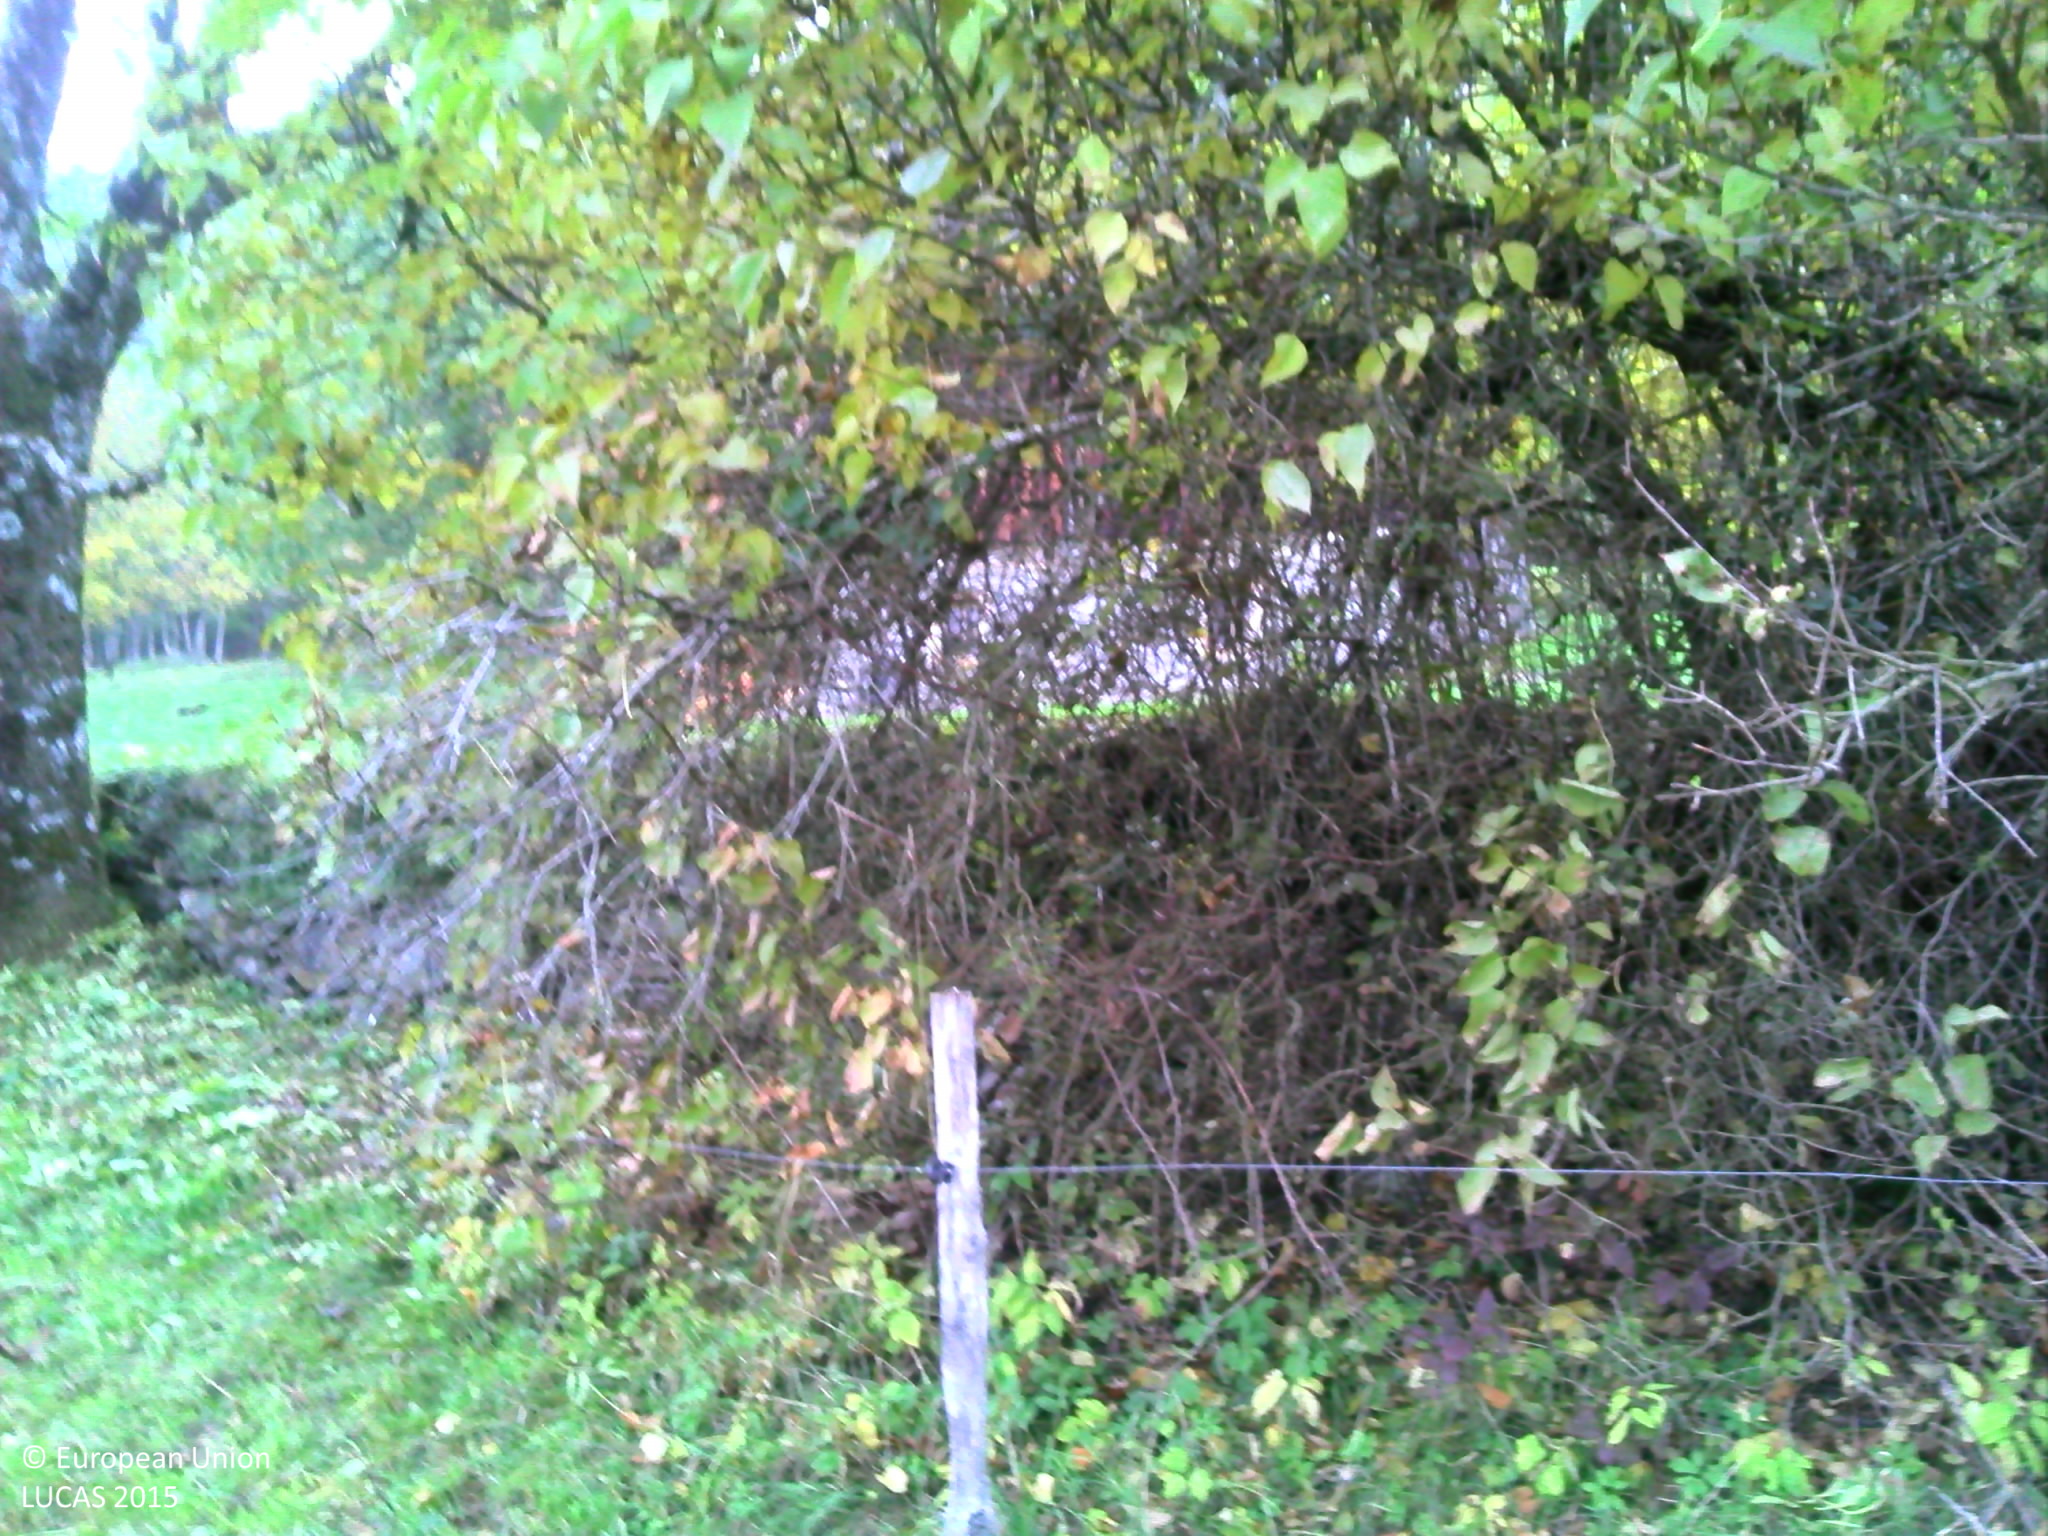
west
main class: Woodland
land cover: Broadleaved woodland
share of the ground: 50 - 75 %
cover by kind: herbaceous plants 70 %, broadleaved forest trees 30 %
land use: Agriculture (excluding fallow land and kitchen gardens)
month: October
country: FR
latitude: 45.5110
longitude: 6.2798
